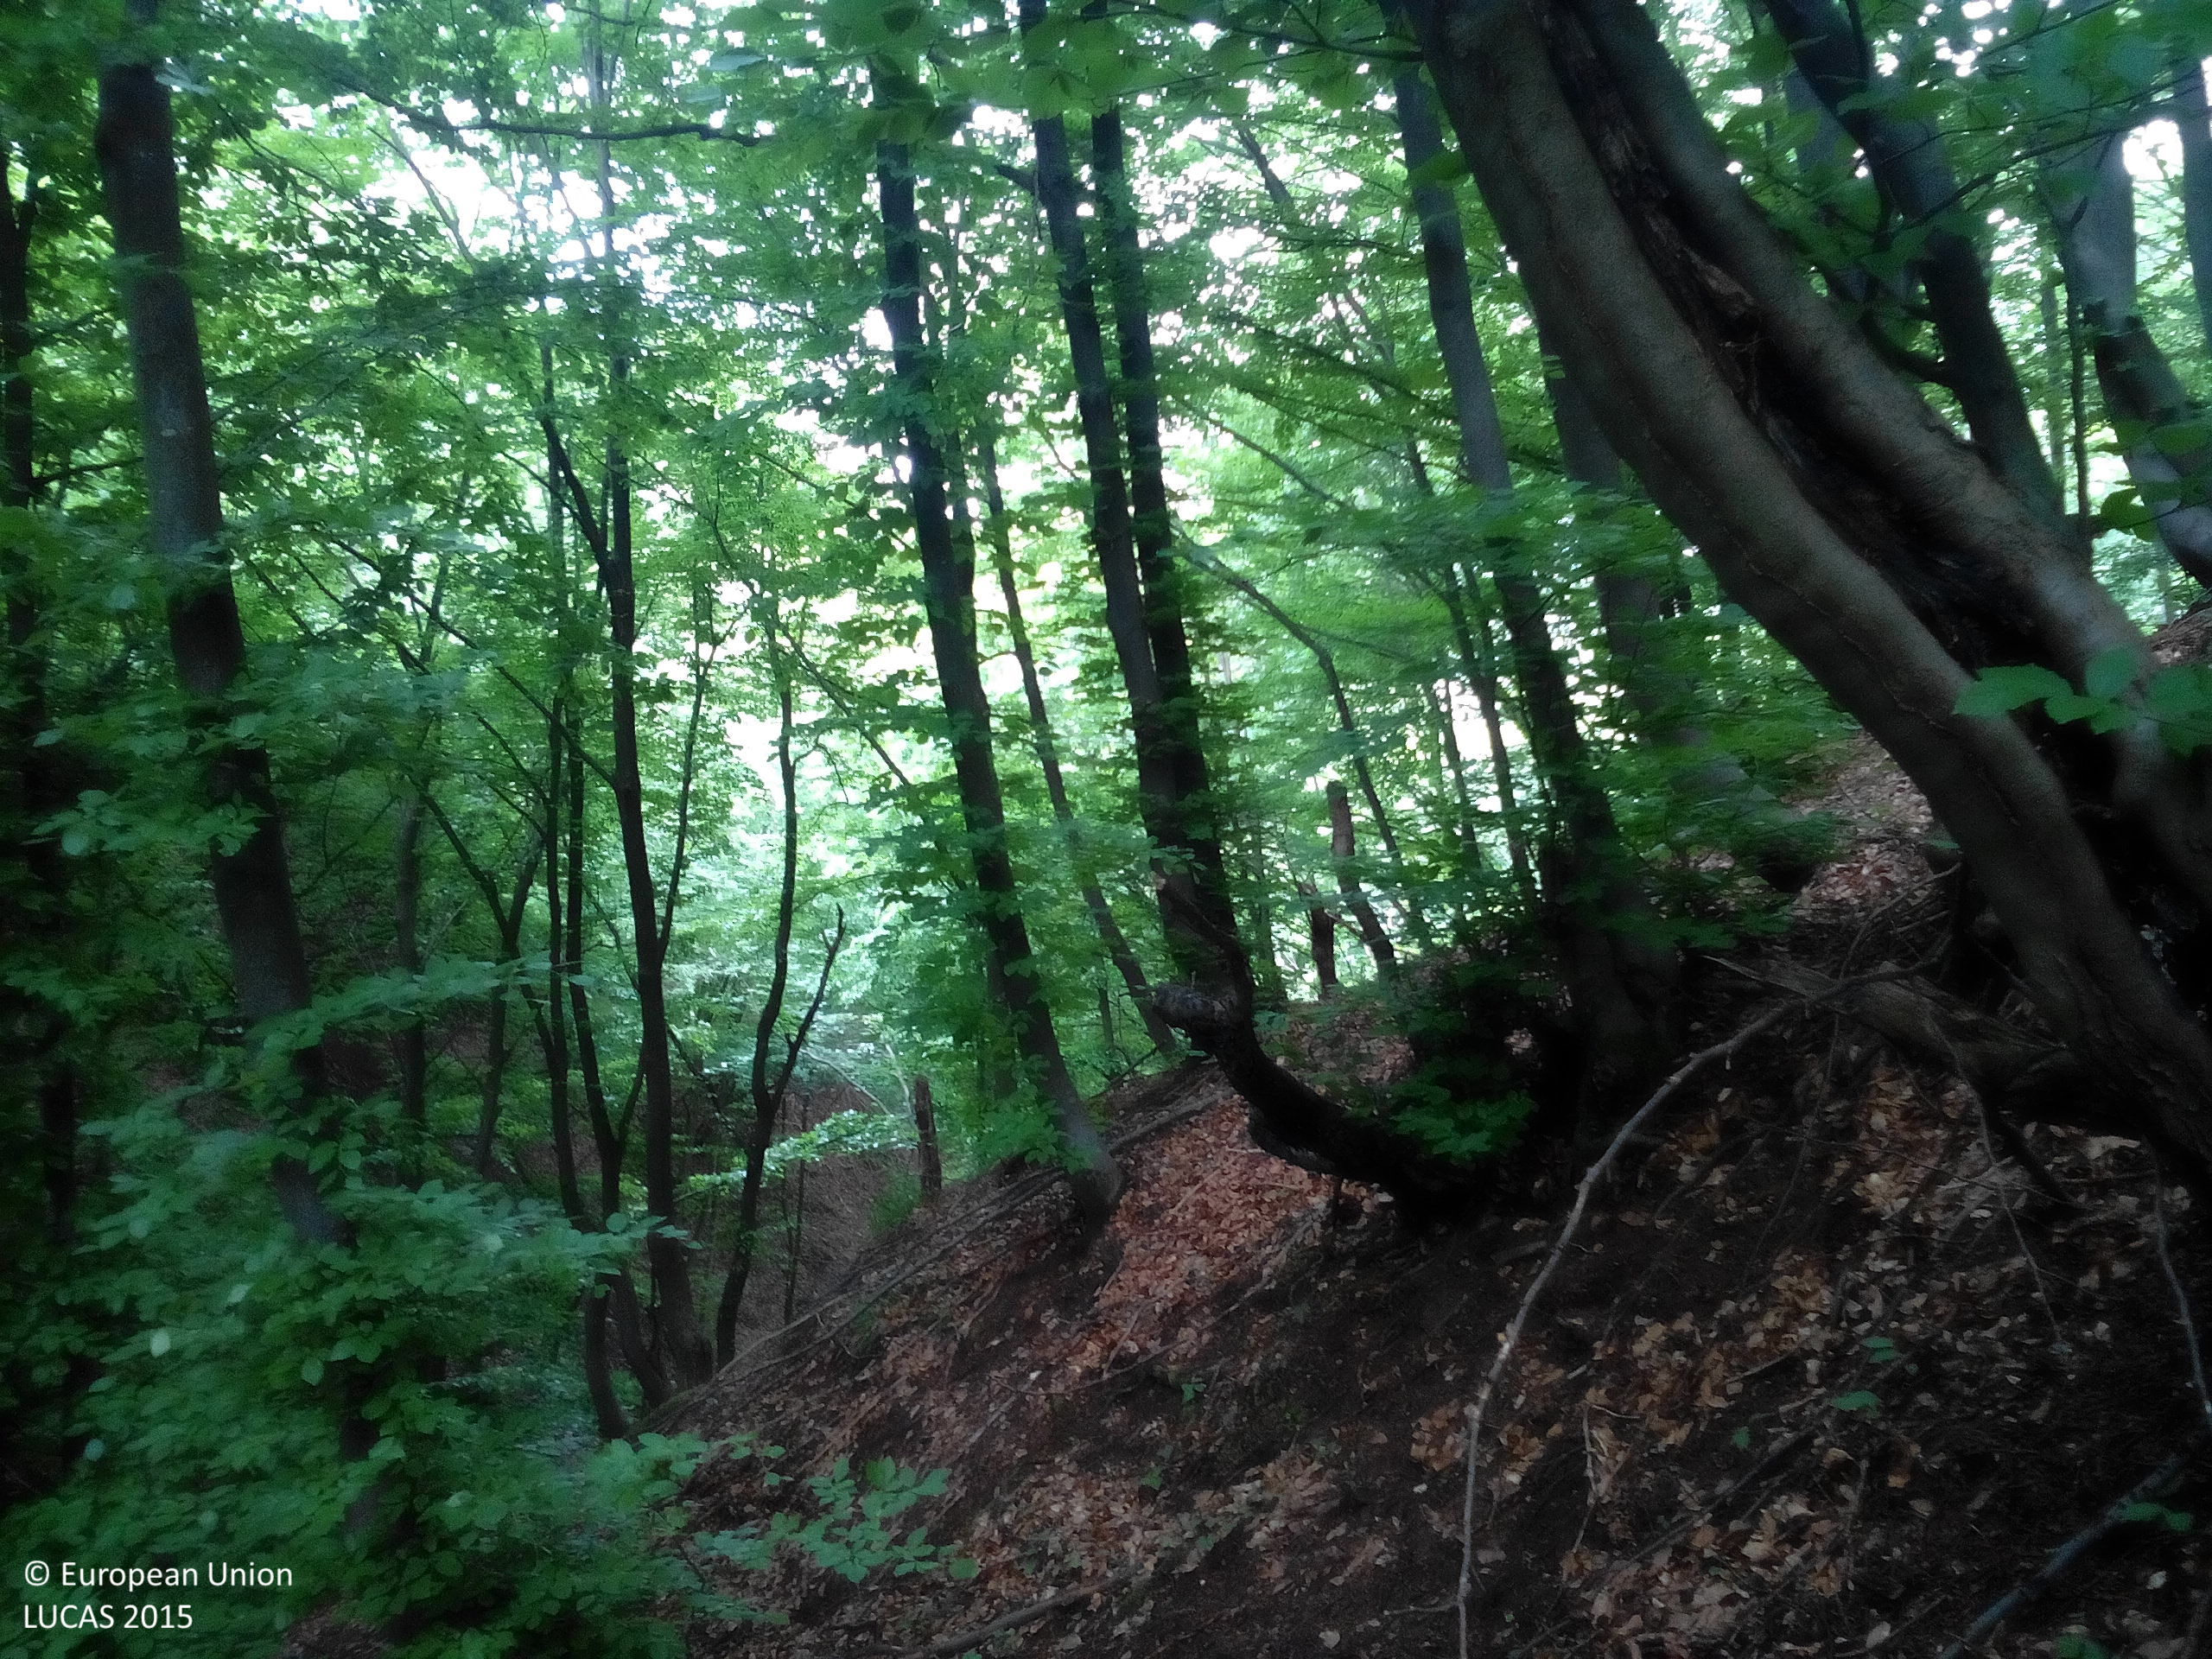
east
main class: Woodland
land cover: Broadleaved woodland
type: beech forest
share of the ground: > 75 %
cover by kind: broadleaved forest trees 100 %
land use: Forestry
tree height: > 5 m
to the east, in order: Broadleaved woodland; Rivers and streams; Broadleaved woodland; Artificial constructions in urban areas; Grassland without tree/shrub cover
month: May
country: BG
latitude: 43.1877
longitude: 23.5151
